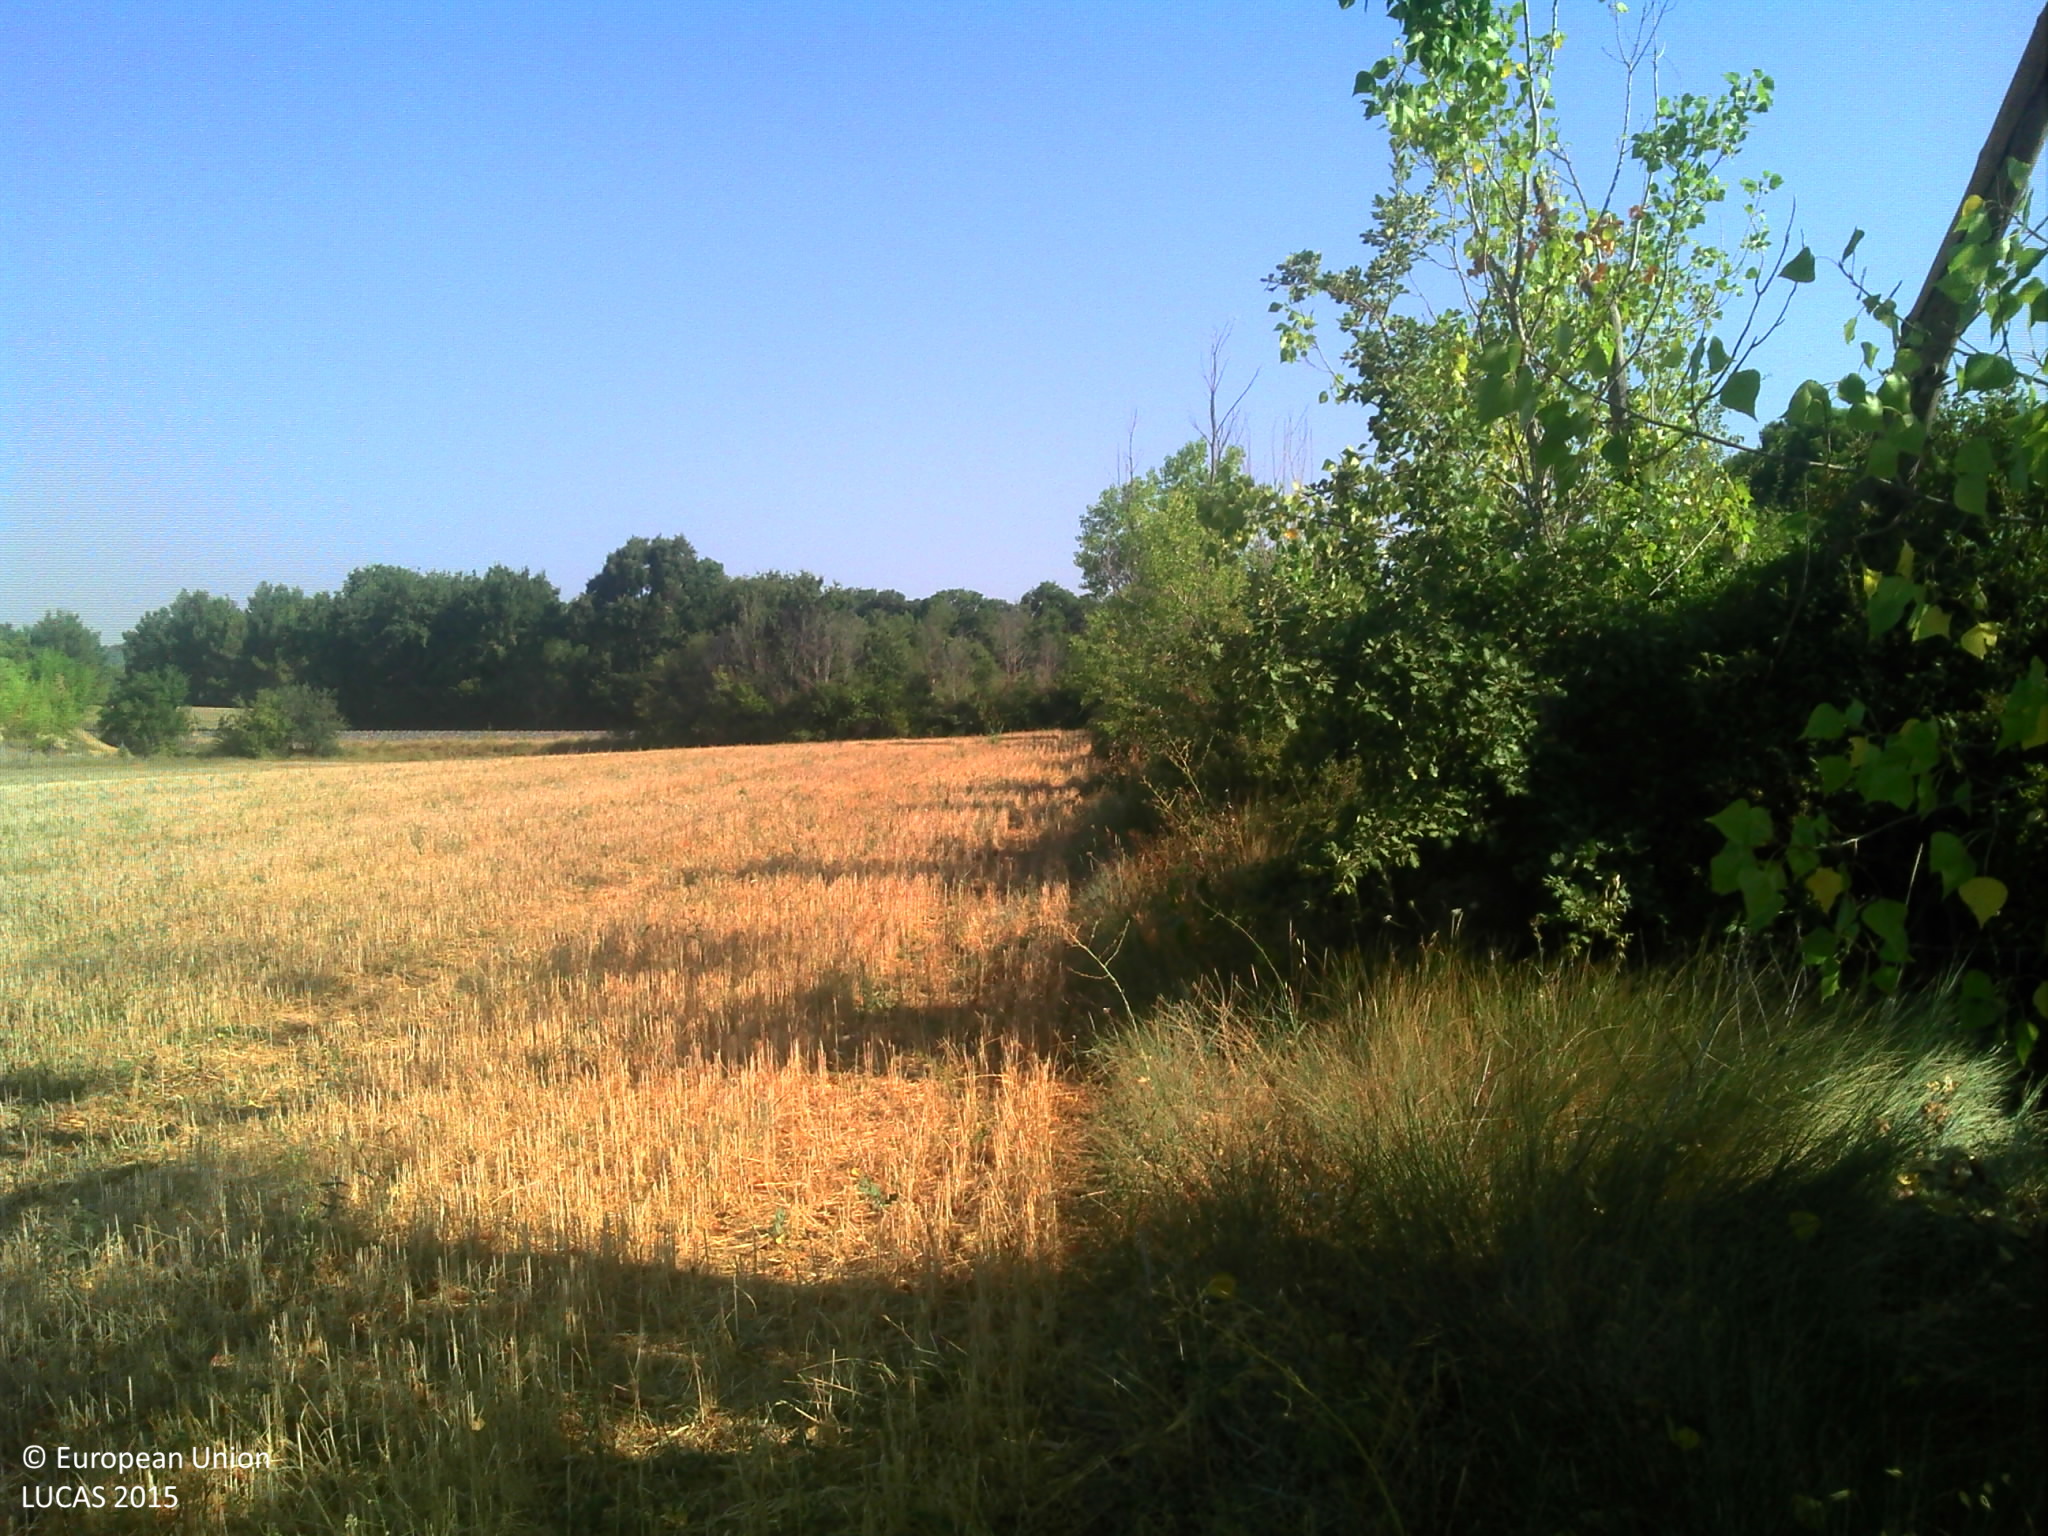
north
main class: Cropland
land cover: Durum wheat
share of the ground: > 75 %
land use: Agriculture (excluding fallow land and kitchen gardens)
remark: Harvested field
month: August
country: FR
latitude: 43.5829
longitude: 5.4644
